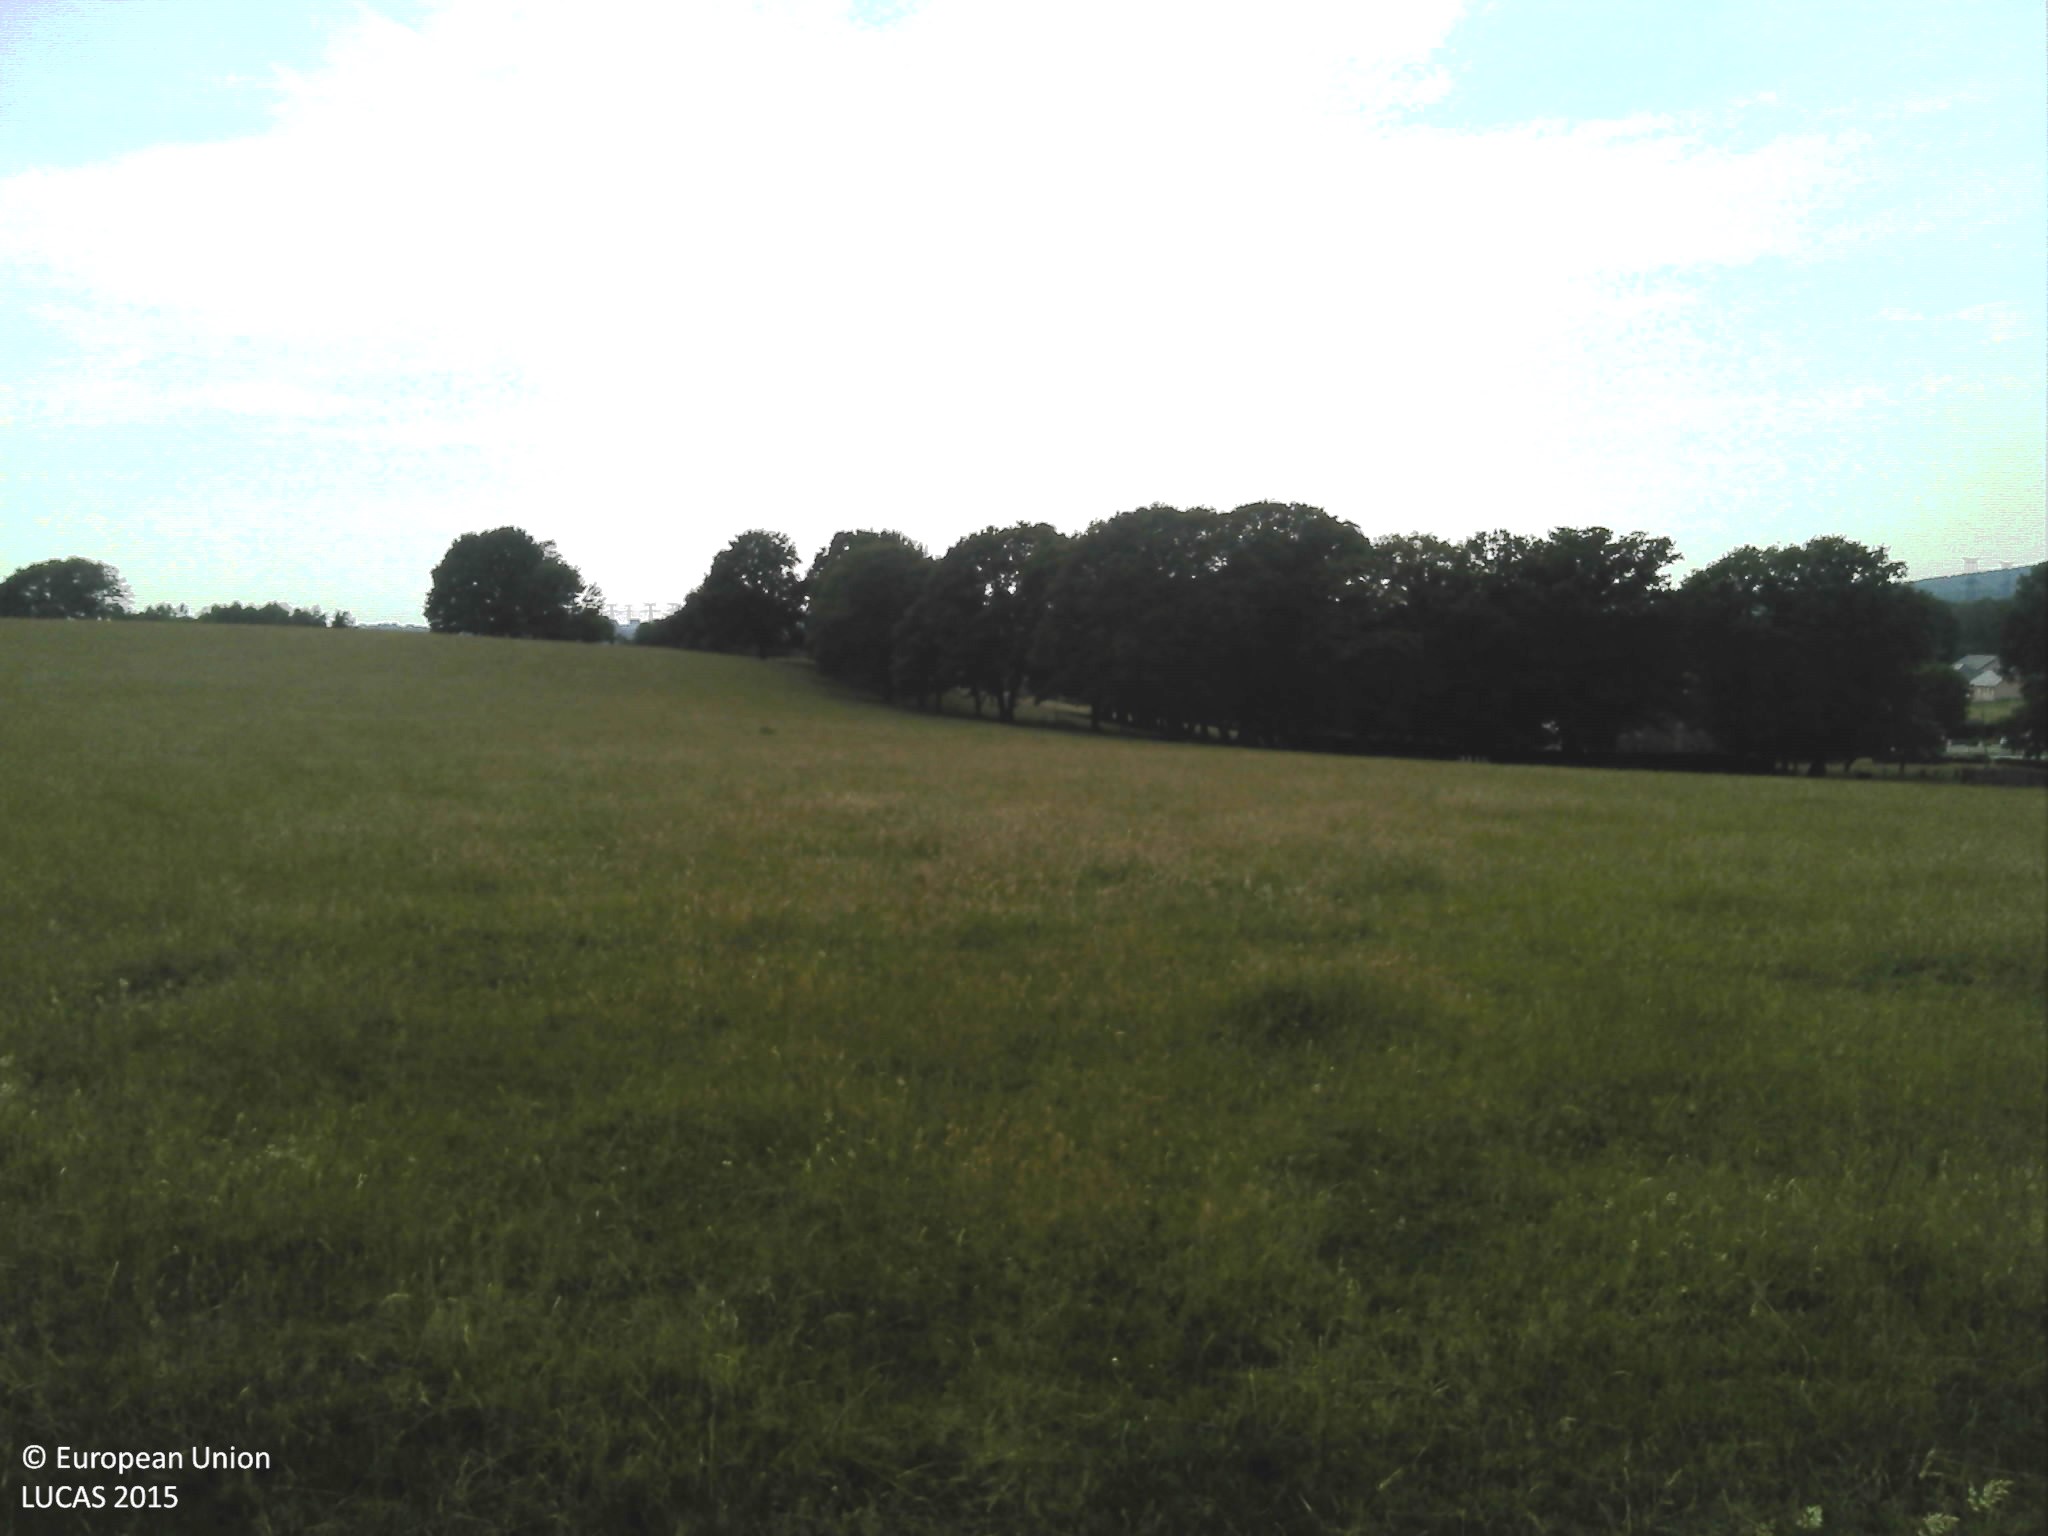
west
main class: Grassland
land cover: Grassland without tree/shrub cover
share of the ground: > 75 %
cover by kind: herbaceous plants 100 %
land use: Agriculture (excluding fallow land and kitchen gardens)
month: July
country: FR
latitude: 49.8613
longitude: 4.6686
